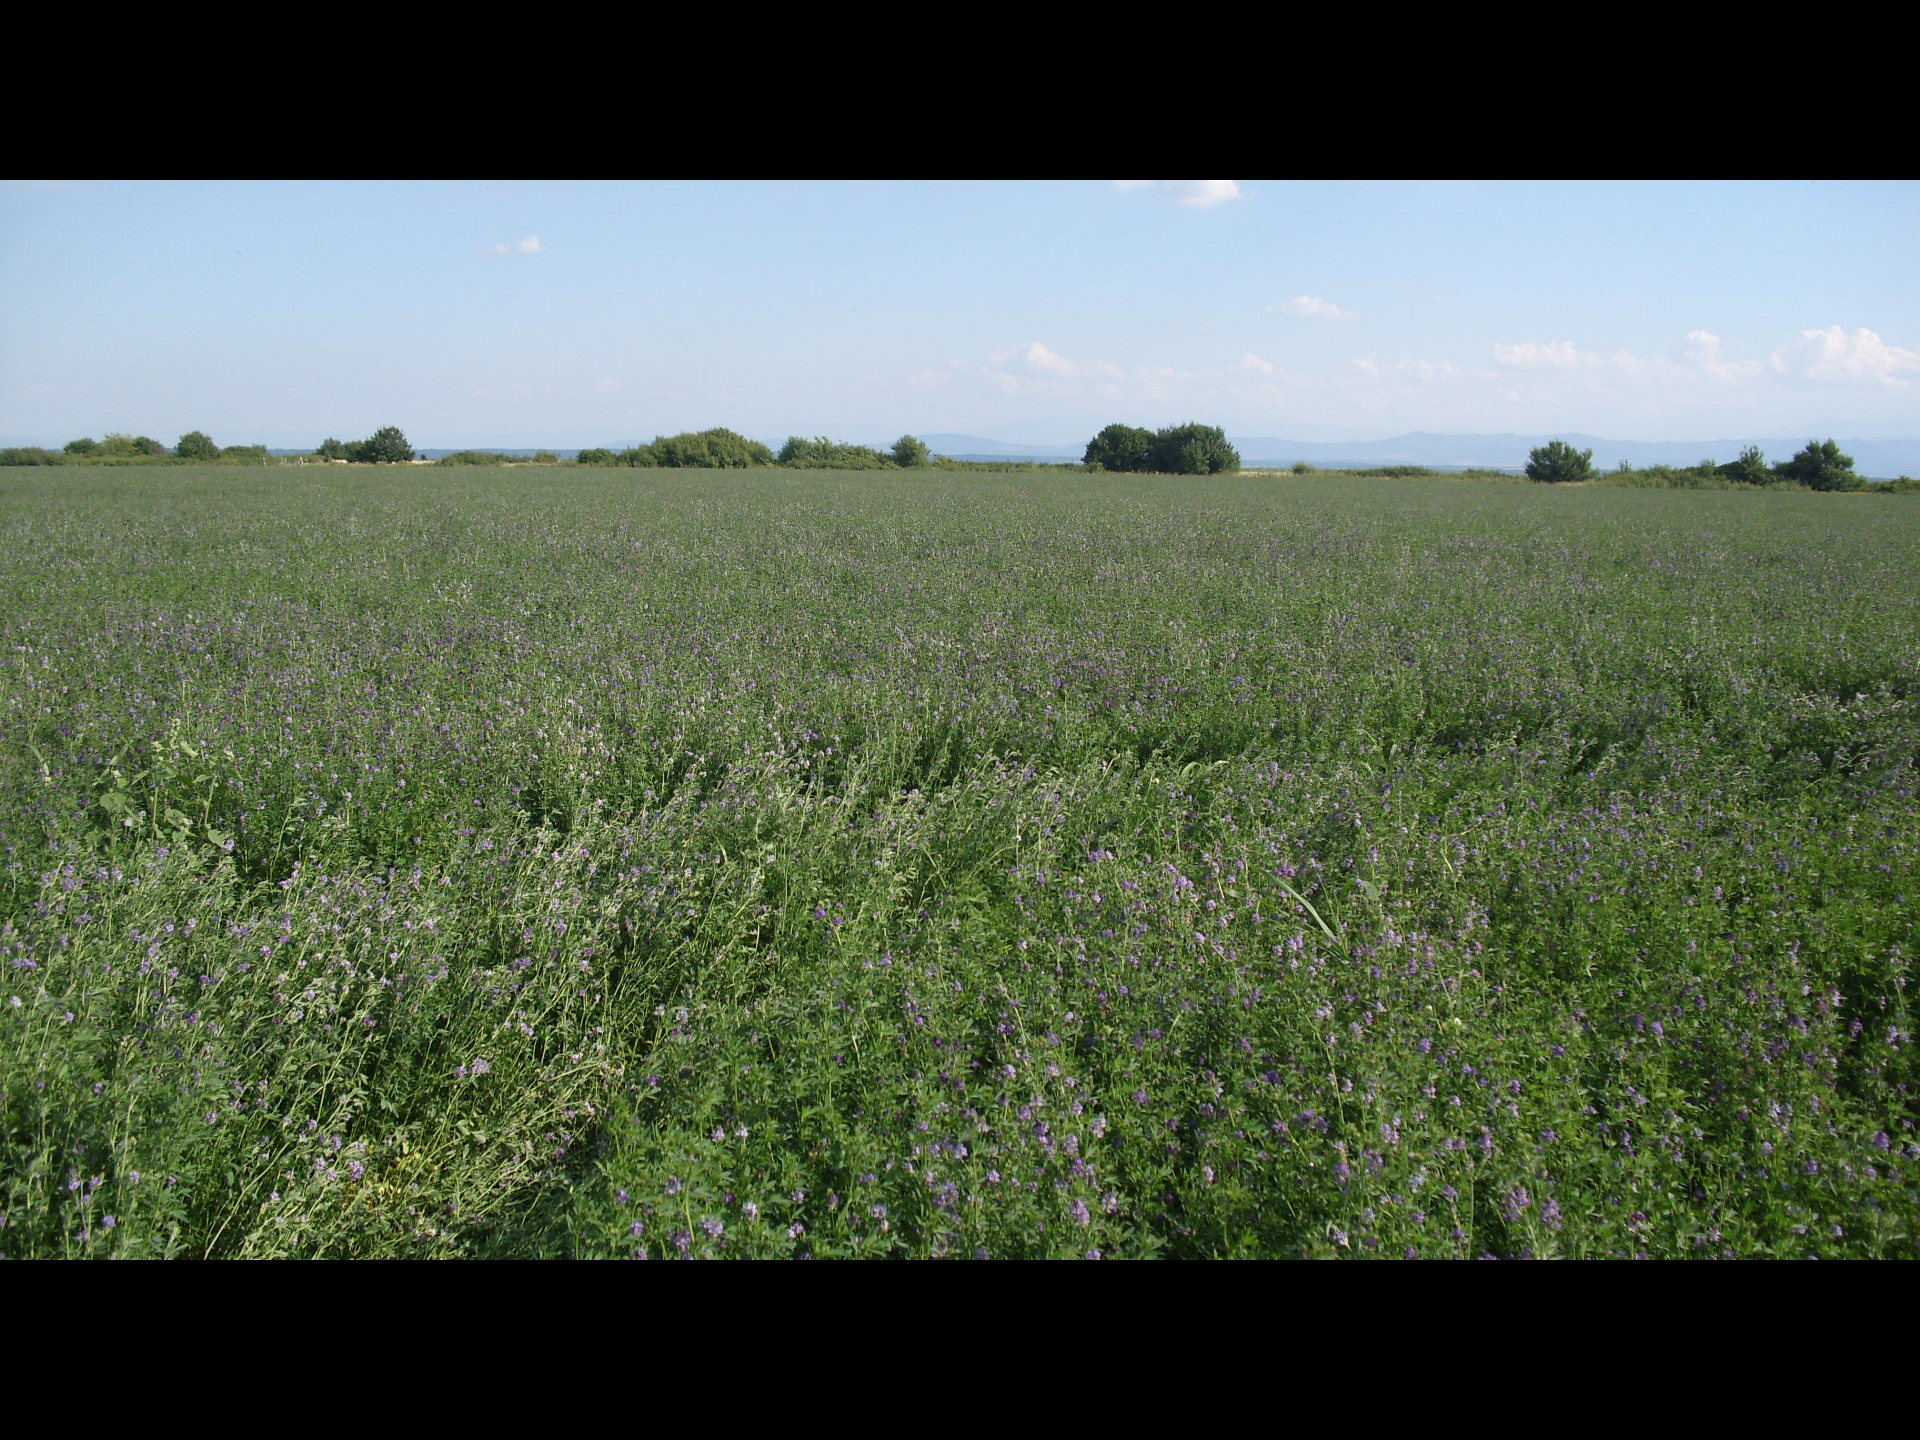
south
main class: Cropland
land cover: Lucerne
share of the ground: > 75 %
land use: Agriculture (excluding fallow land and kitchen gardens)
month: July
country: BG
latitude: 43.7458
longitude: 23.0163
